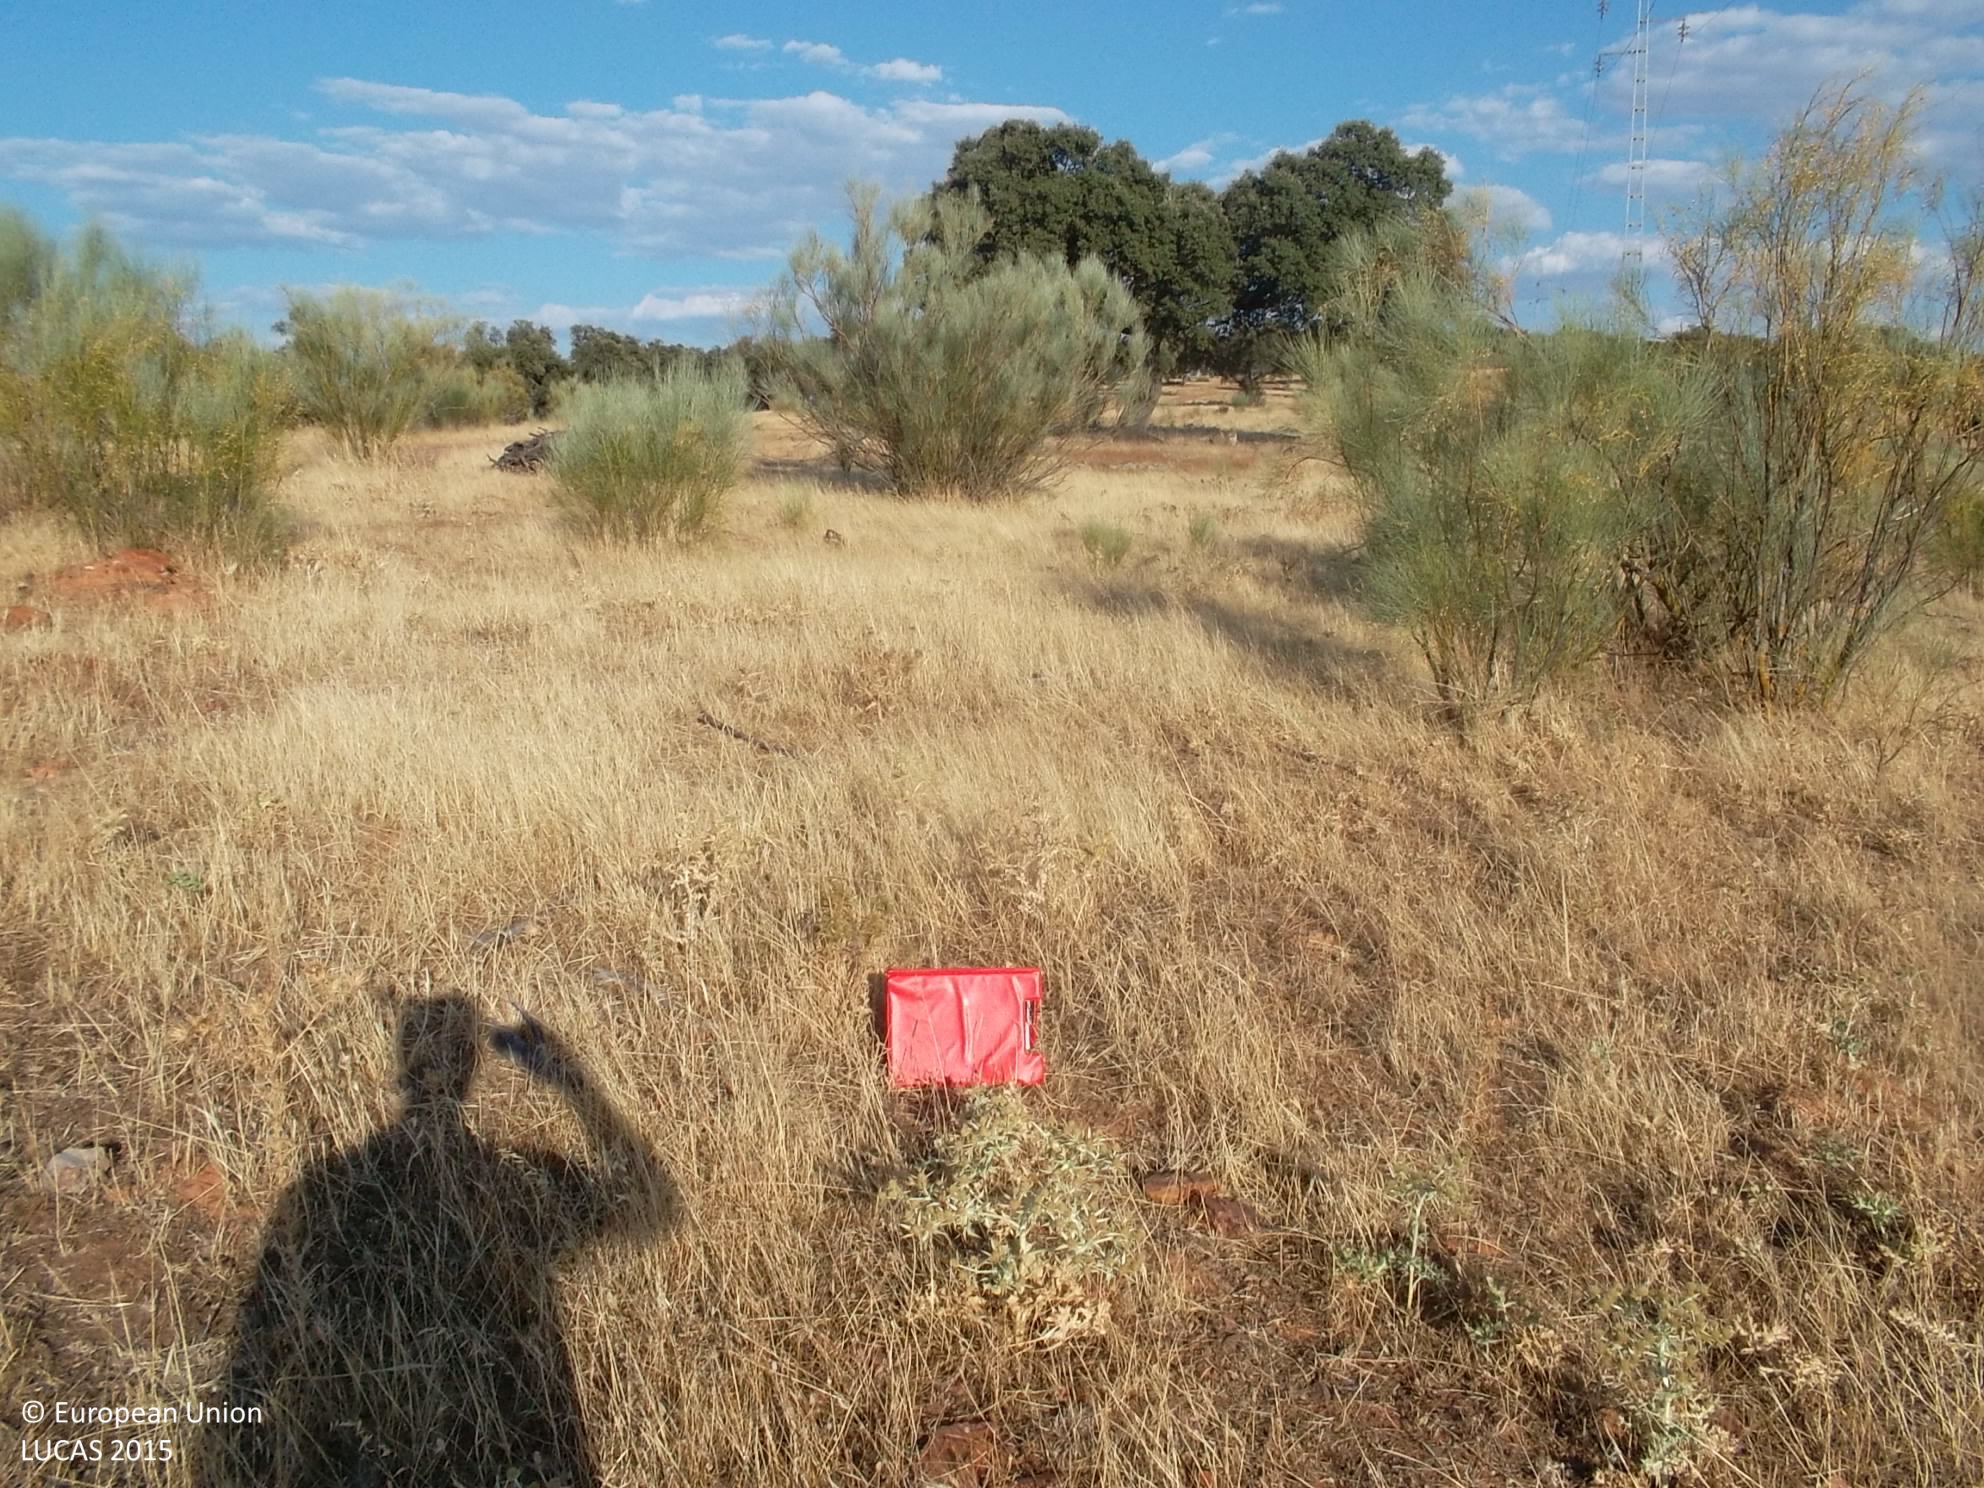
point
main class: Grassland
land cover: Grassland with sparse tree/shrub cover
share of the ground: > 75 %
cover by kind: herbaceous plants 90 %, broadleaved forest trees 5 %, shrubs 5 %
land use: Agriculture (excluding fallow land and kitchen gardens)
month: July
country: ES
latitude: 38.5338
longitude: -5.8150
